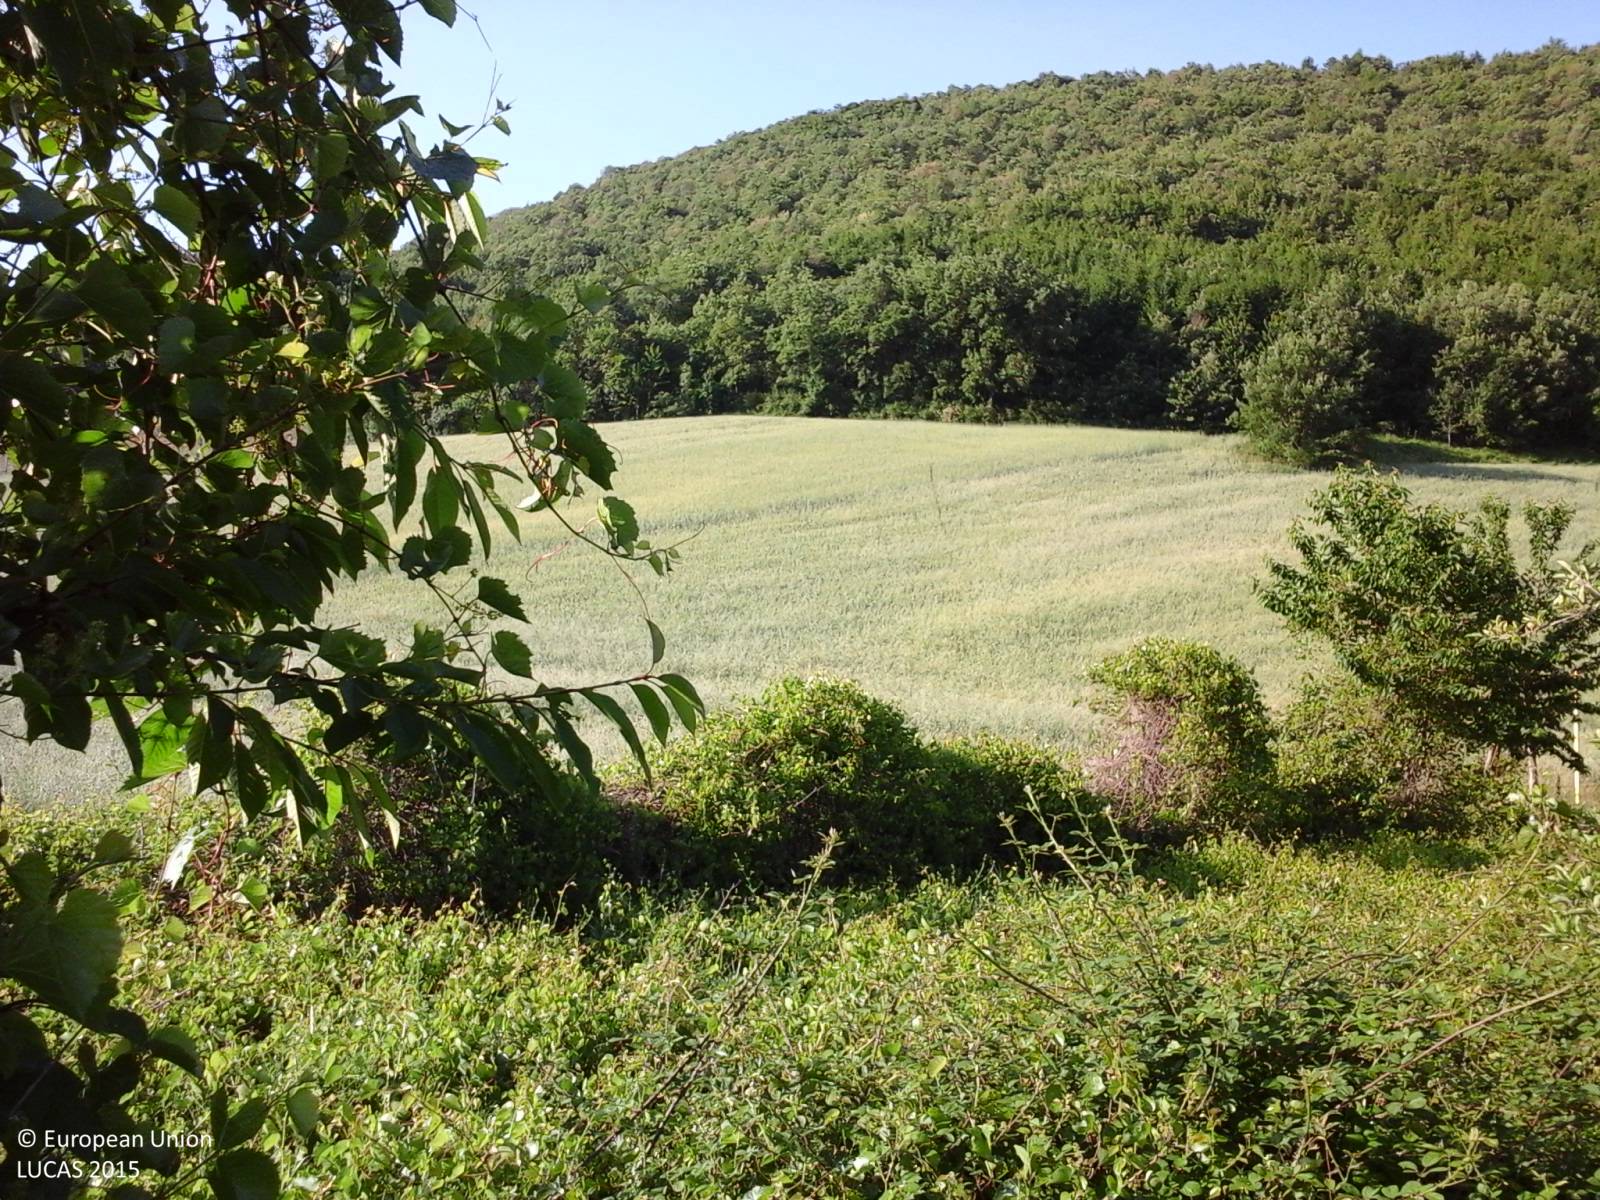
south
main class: Shrubland
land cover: Shrubland with sparse tree cover
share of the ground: > 75 %
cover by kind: shrubs 95 %, broadleaved forest trees 5 %
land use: Abandoned areas
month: June
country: IT
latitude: 42.0775
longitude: 13.7708
